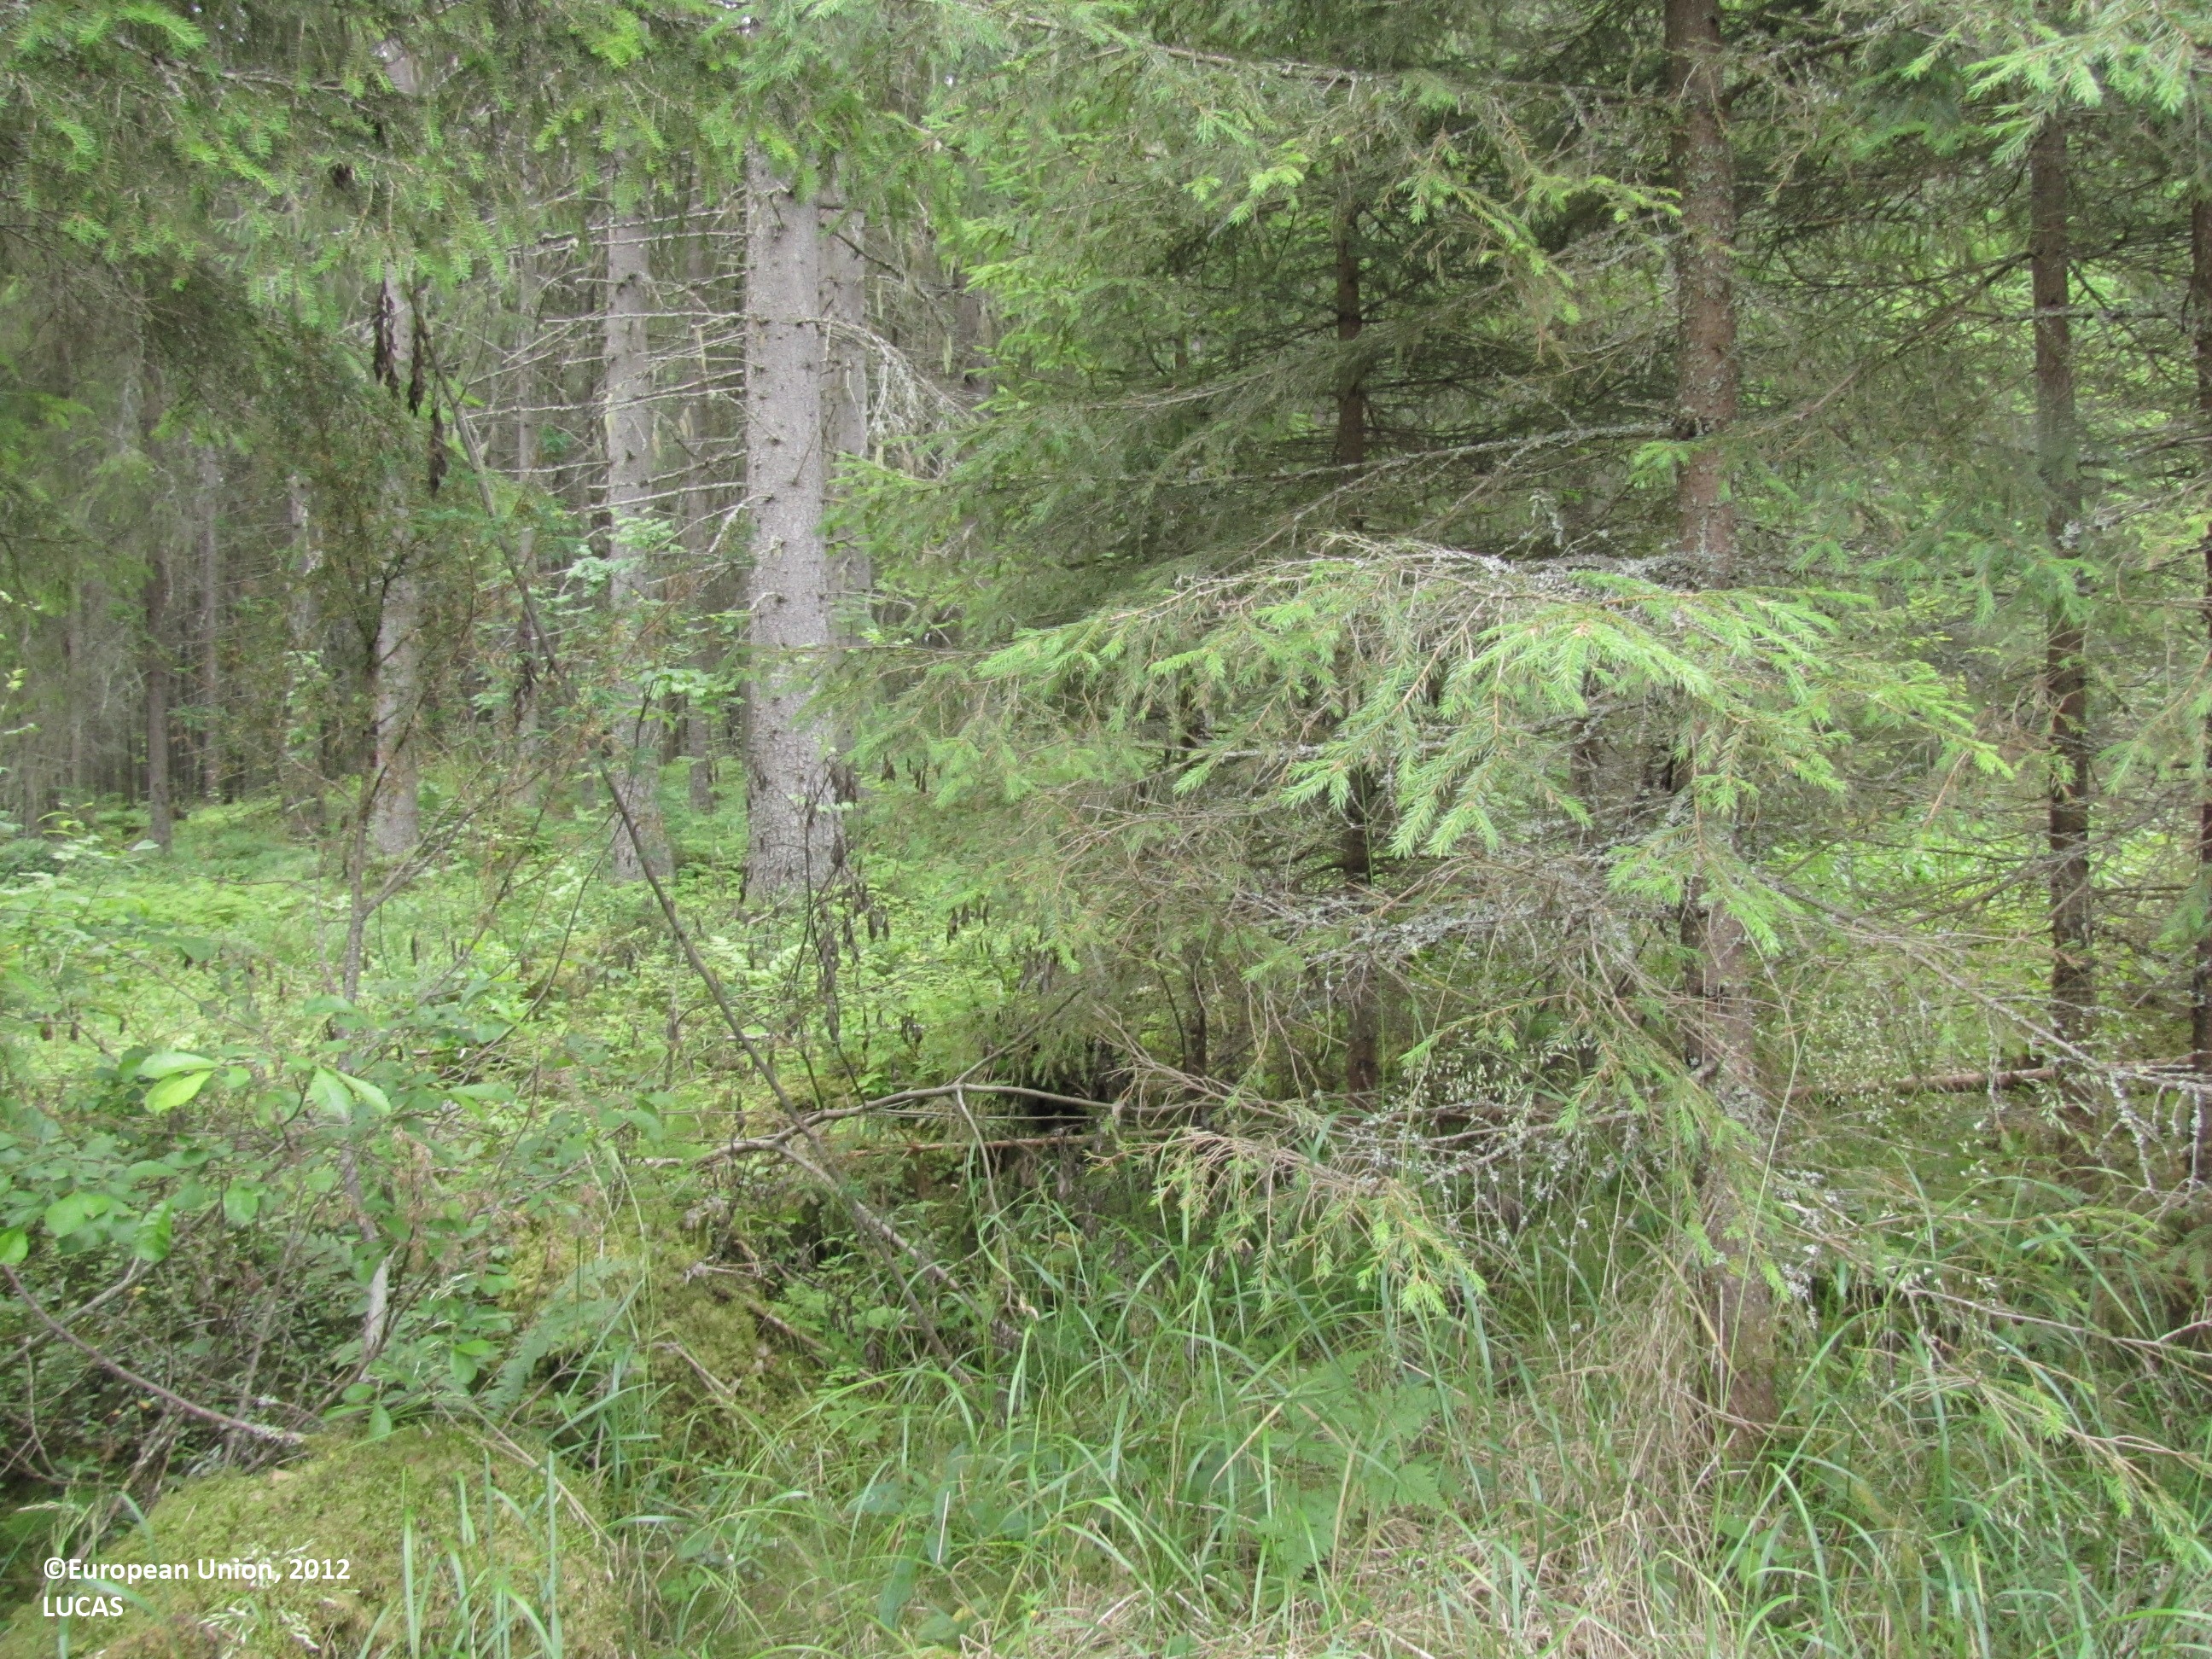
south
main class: Woodland
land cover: Spruce dominated coniferous woodland
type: boreal forest
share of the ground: > 75 %
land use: Forestry
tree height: > 5 m
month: July
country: FI
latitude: 62.6876
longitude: 23.4106
